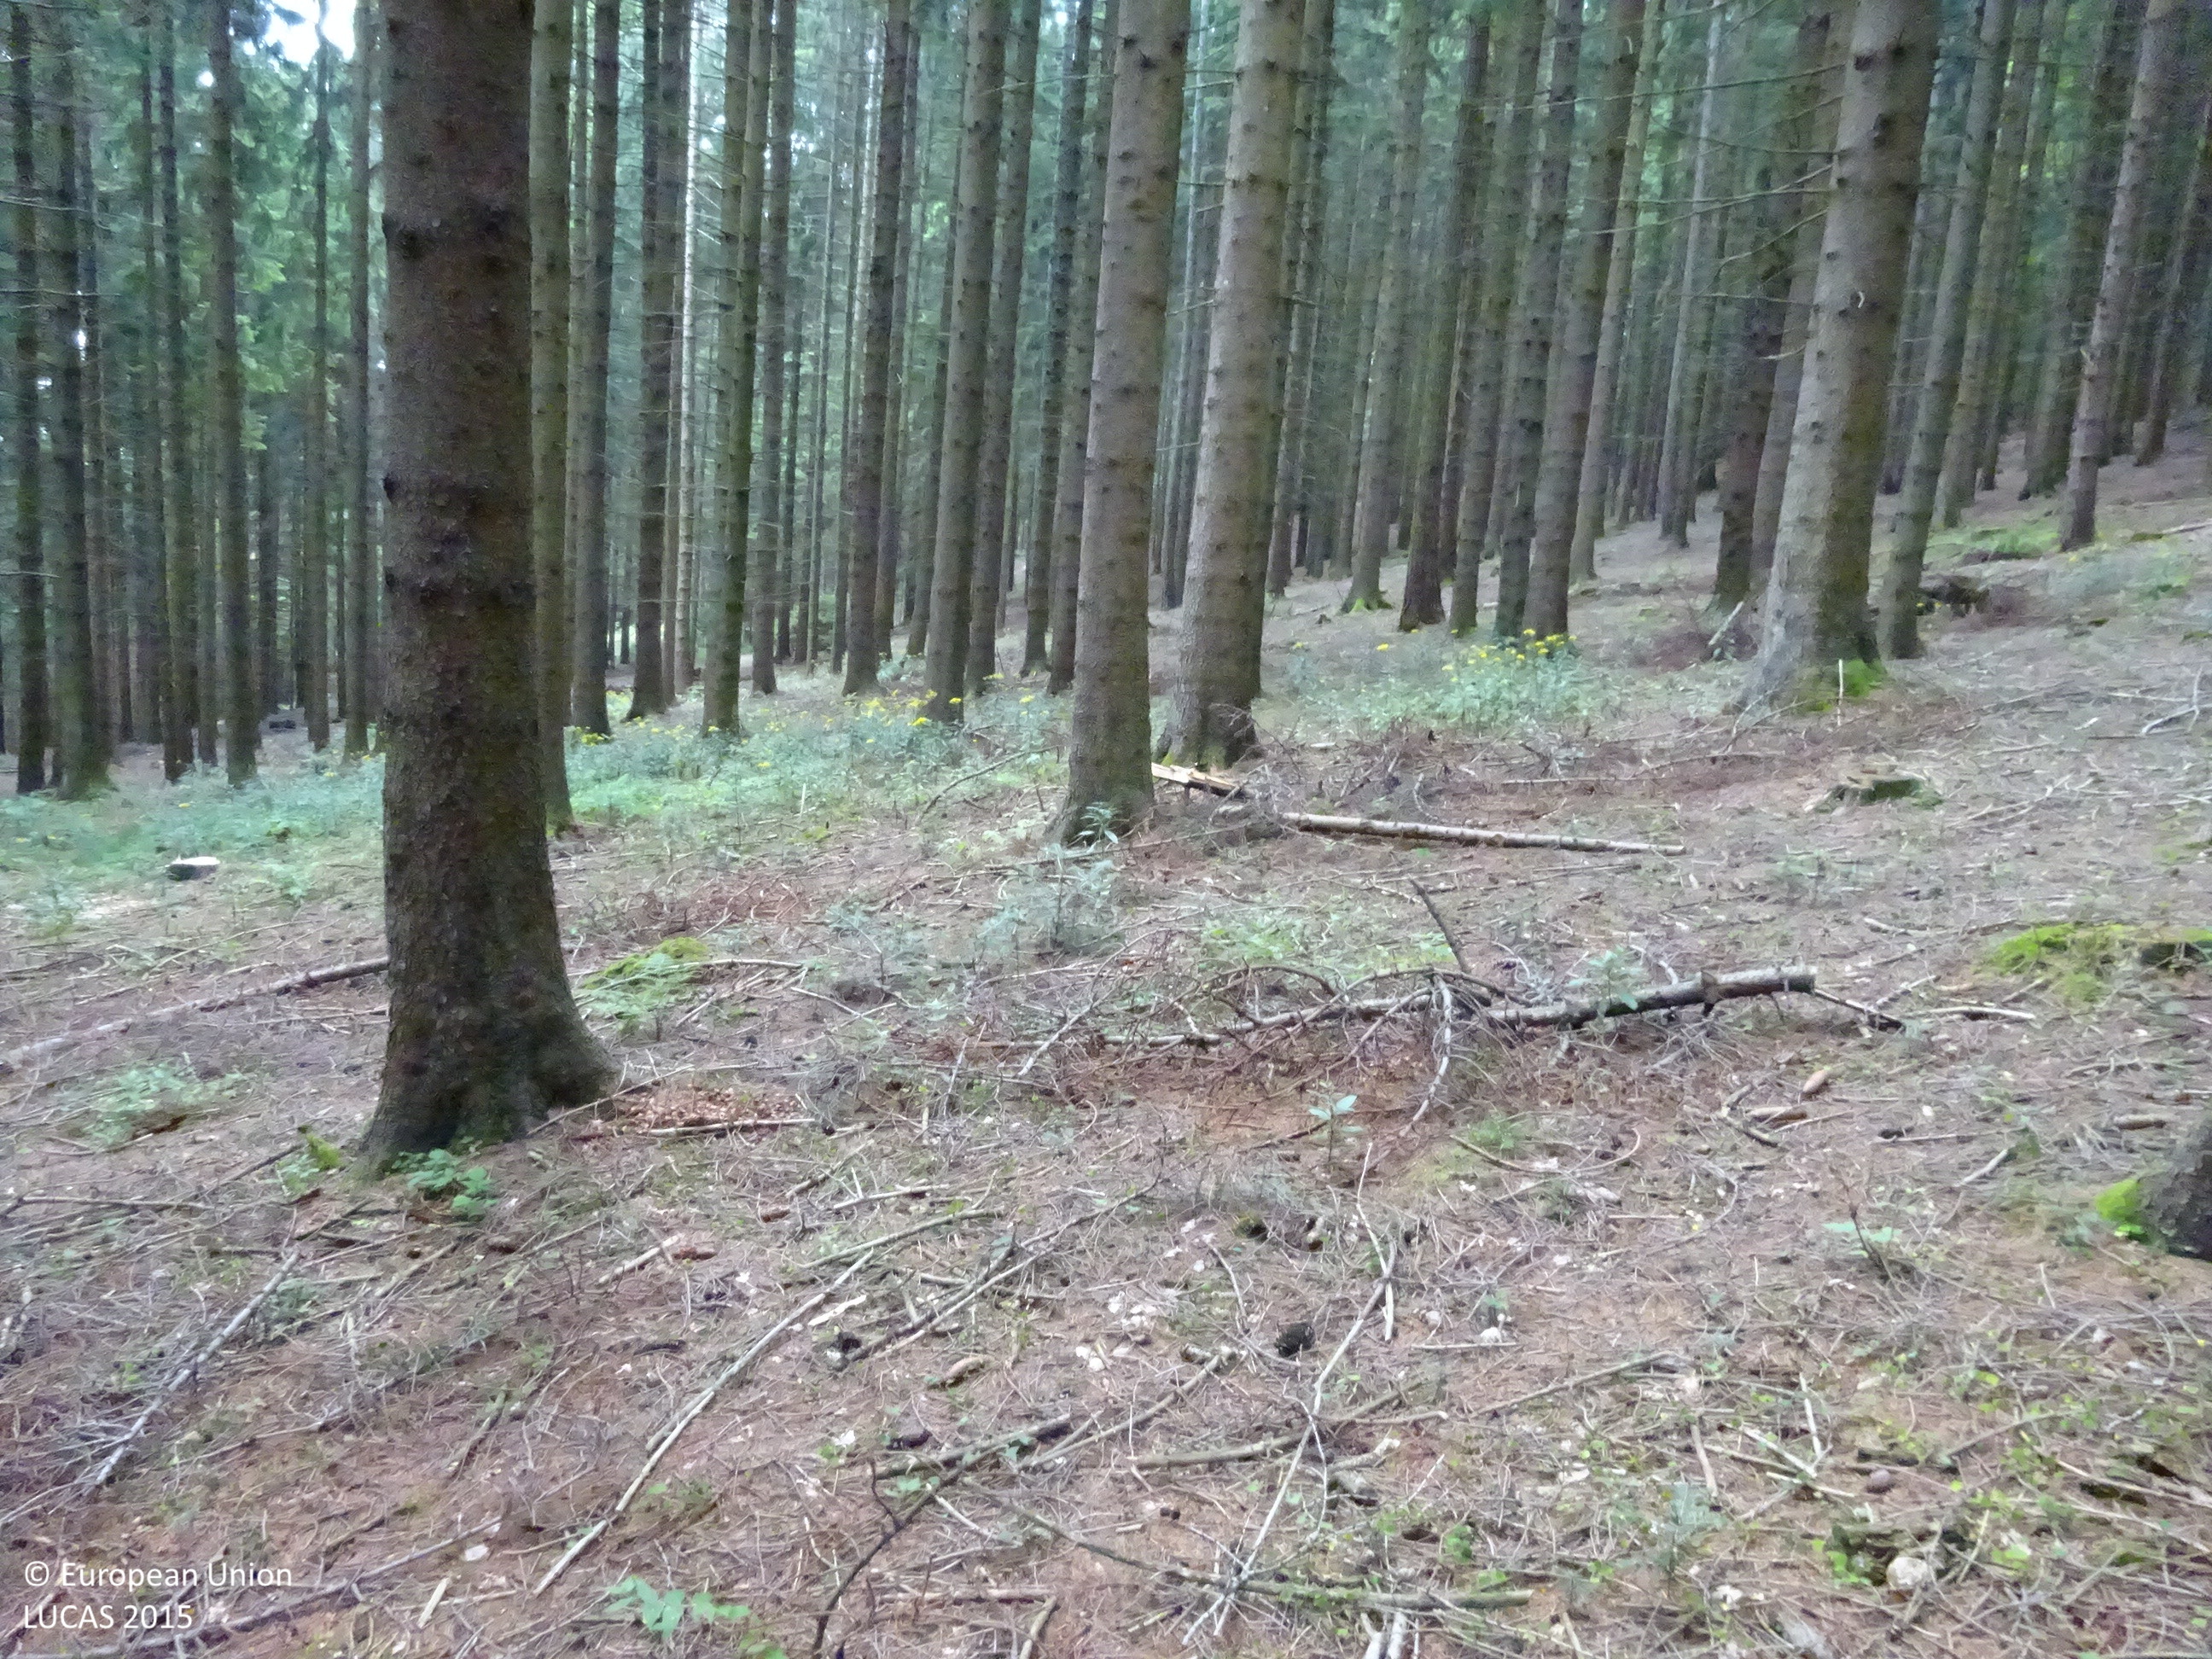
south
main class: Woodland
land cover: Spruce dominated coniferous woodland
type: alpine coniferous forest
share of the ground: > 75 %
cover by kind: coniferous forest trees 90 %, unconsolidated bare surface 10 %
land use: Forestry
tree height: > 5 m
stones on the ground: < 10 %
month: August
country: AT
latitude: 47.3513
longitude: 15.7597
